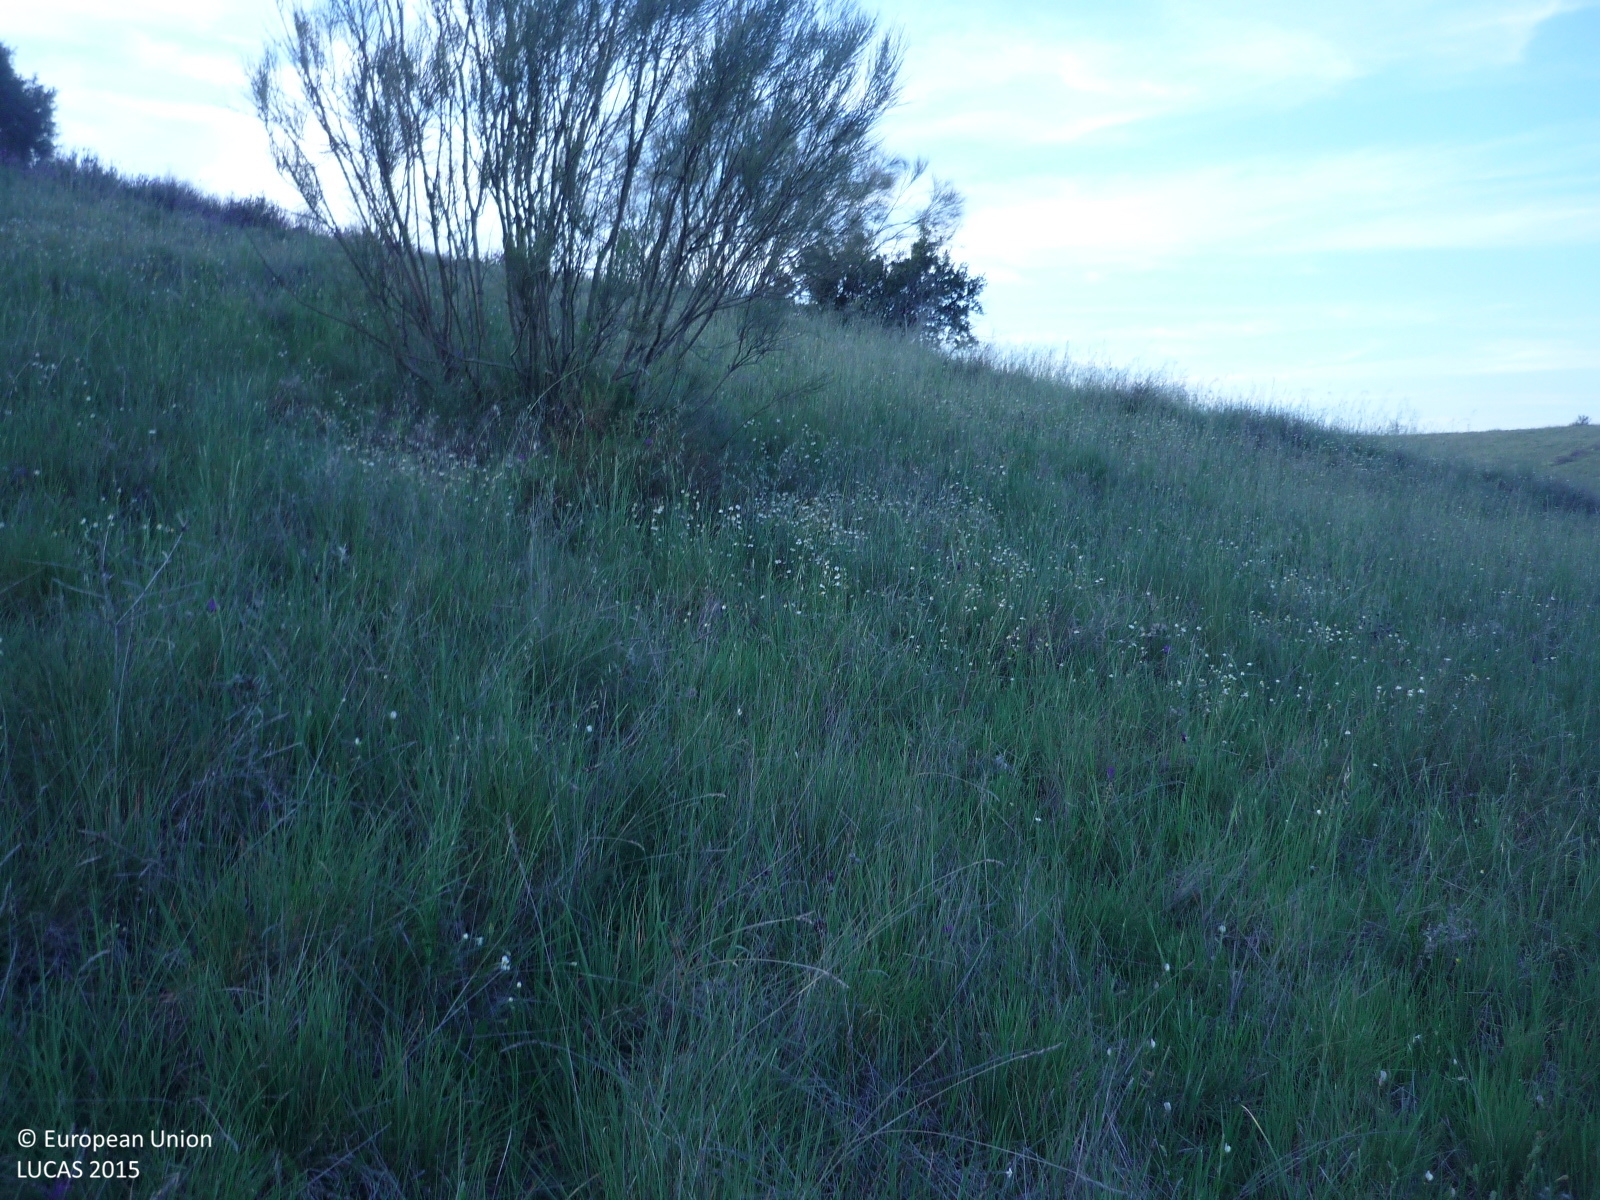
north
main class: Grassland
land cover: Grassland with sparse tree/shrub cover
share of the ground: > 75 %
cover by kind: herbaceous plants 85 %, shrubs 10 %, broadleaved forest trees 5 %
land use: Agriculture (excluding fallow land and kitchen gardens)
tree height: < 5 m
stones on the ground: < 10 %
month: April
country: ES
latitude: 40.7083
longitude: -3.5925
